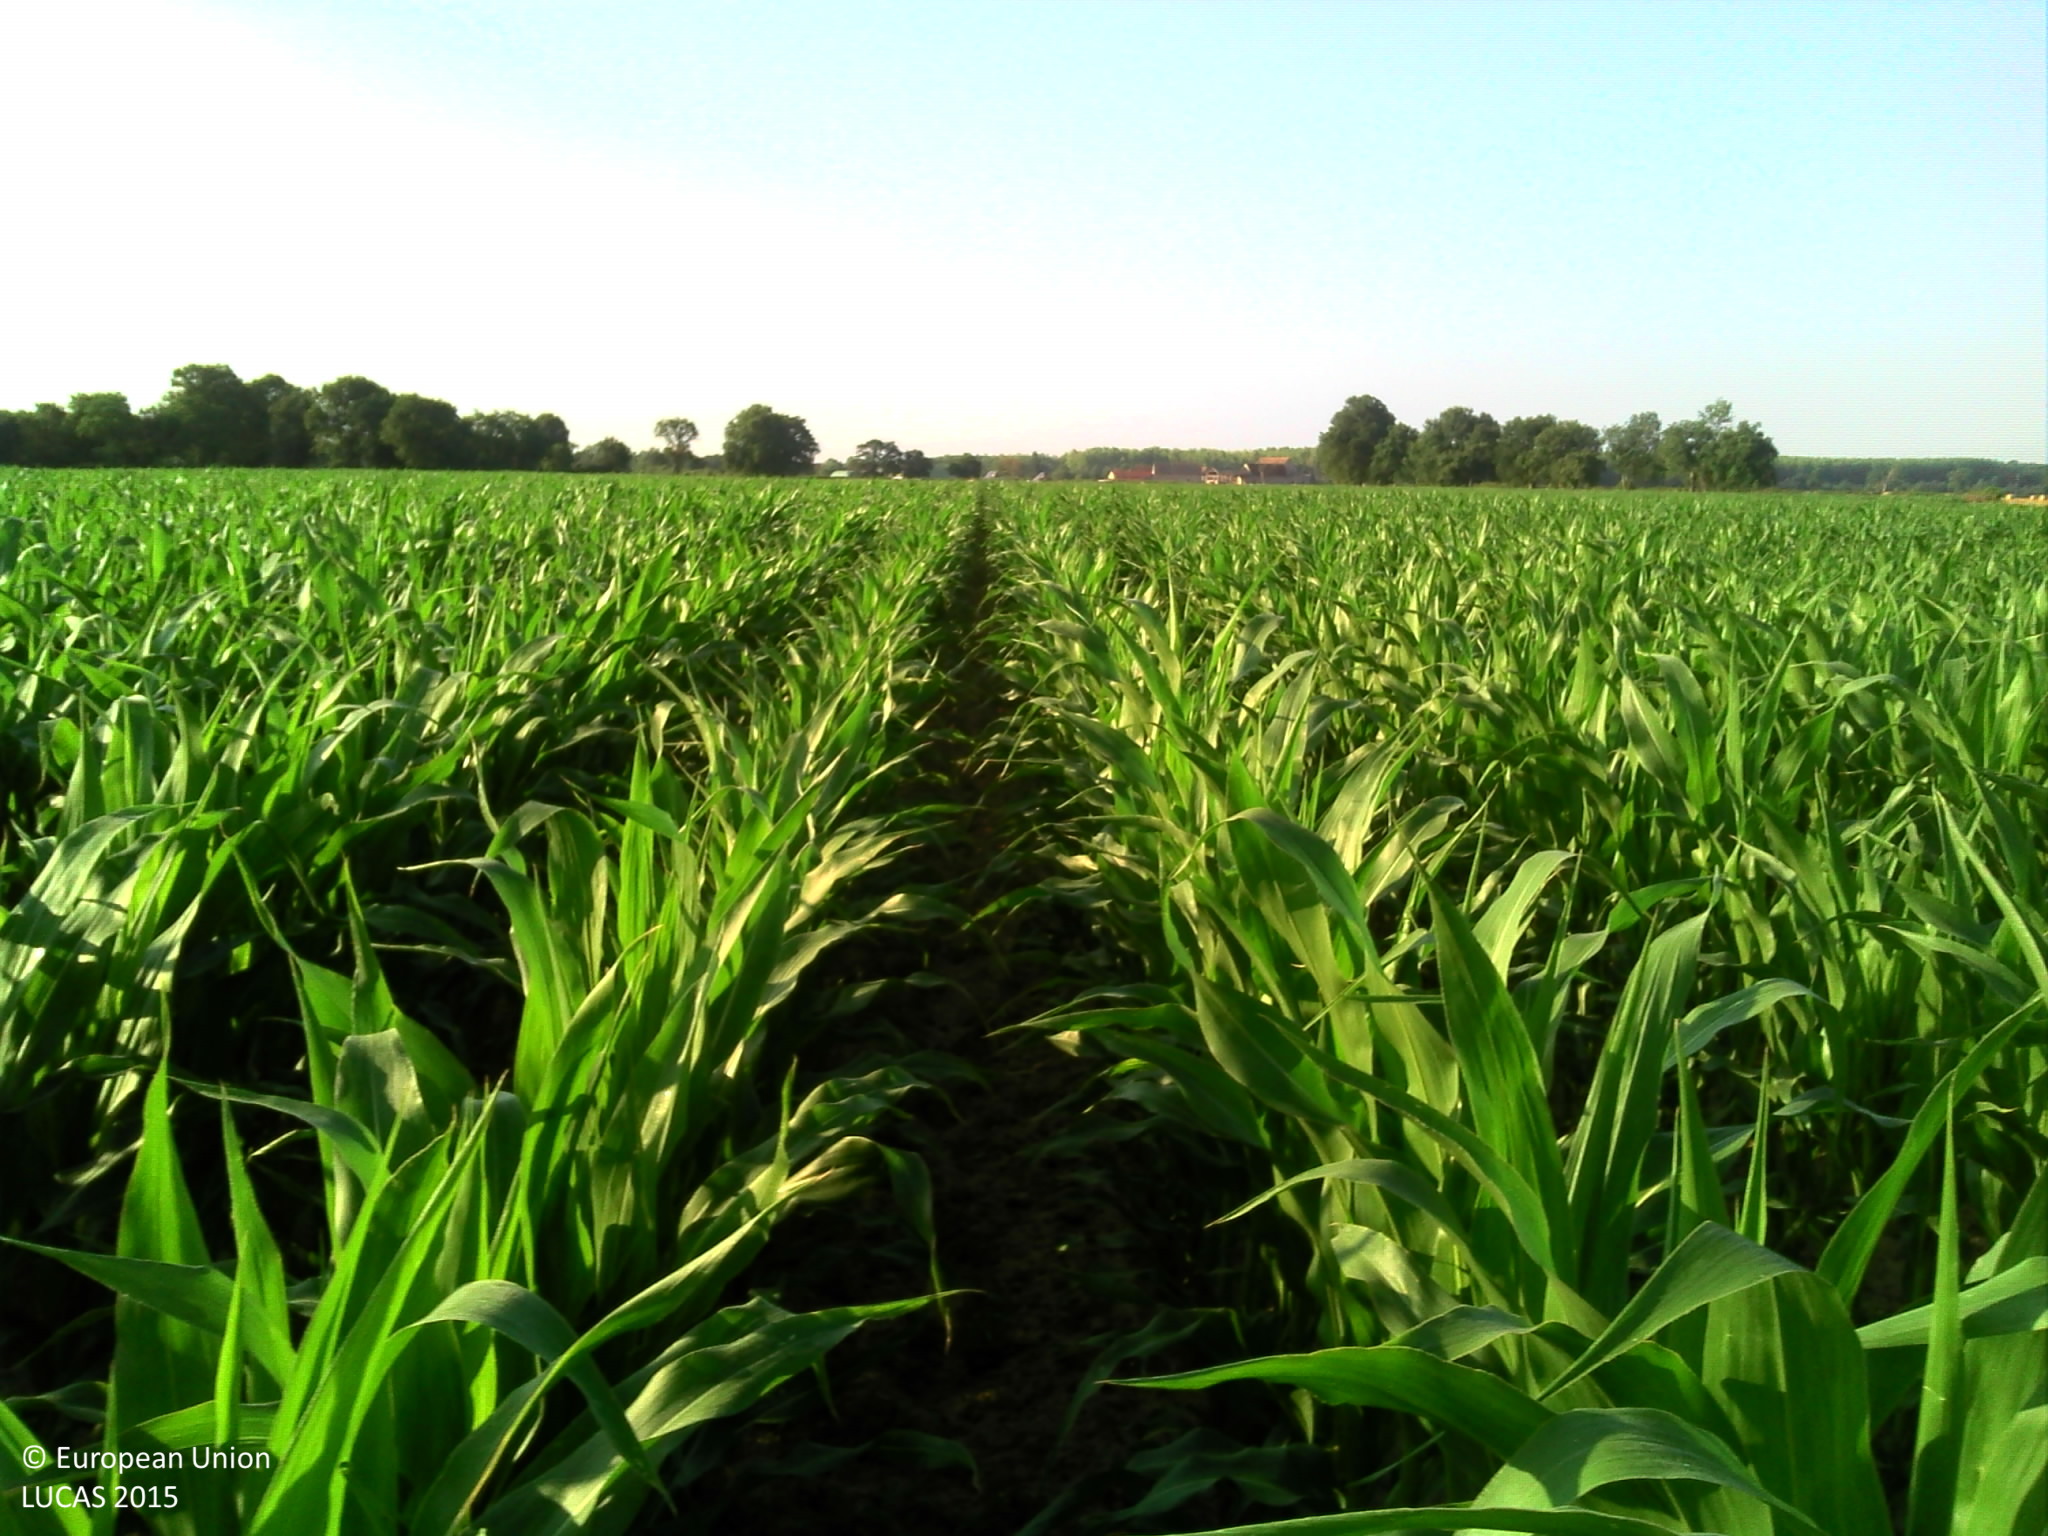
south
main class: Cropland
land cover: Maize
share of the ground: > 75 %
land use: Agriculture (excluding fallow land and kitchen gardens)
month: July
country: FR
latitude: 46.8976
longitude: 3.2632
